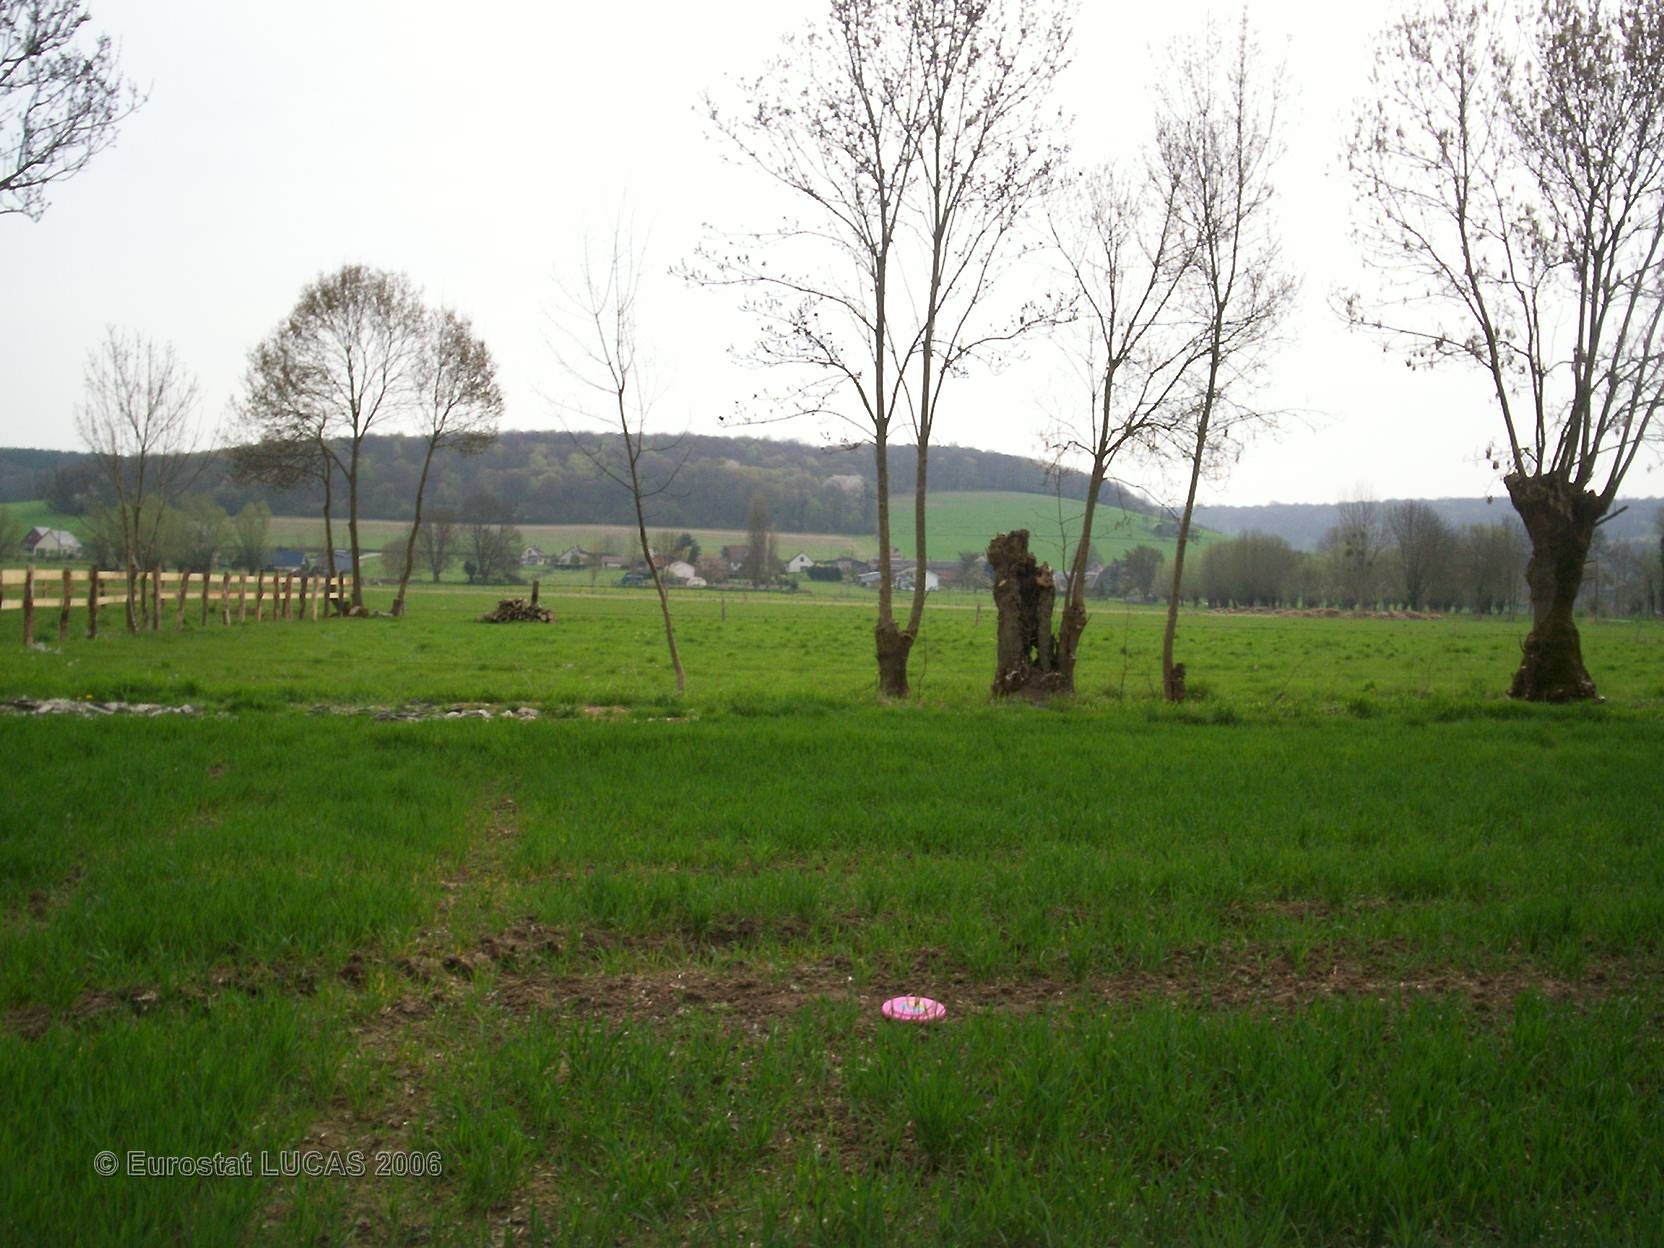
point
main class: Cropland
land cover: Common wheat
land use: Agriculture (excluding fallow land and kitchen gardens)
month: April
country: FR
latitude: 49.4253
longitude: 0.9469
